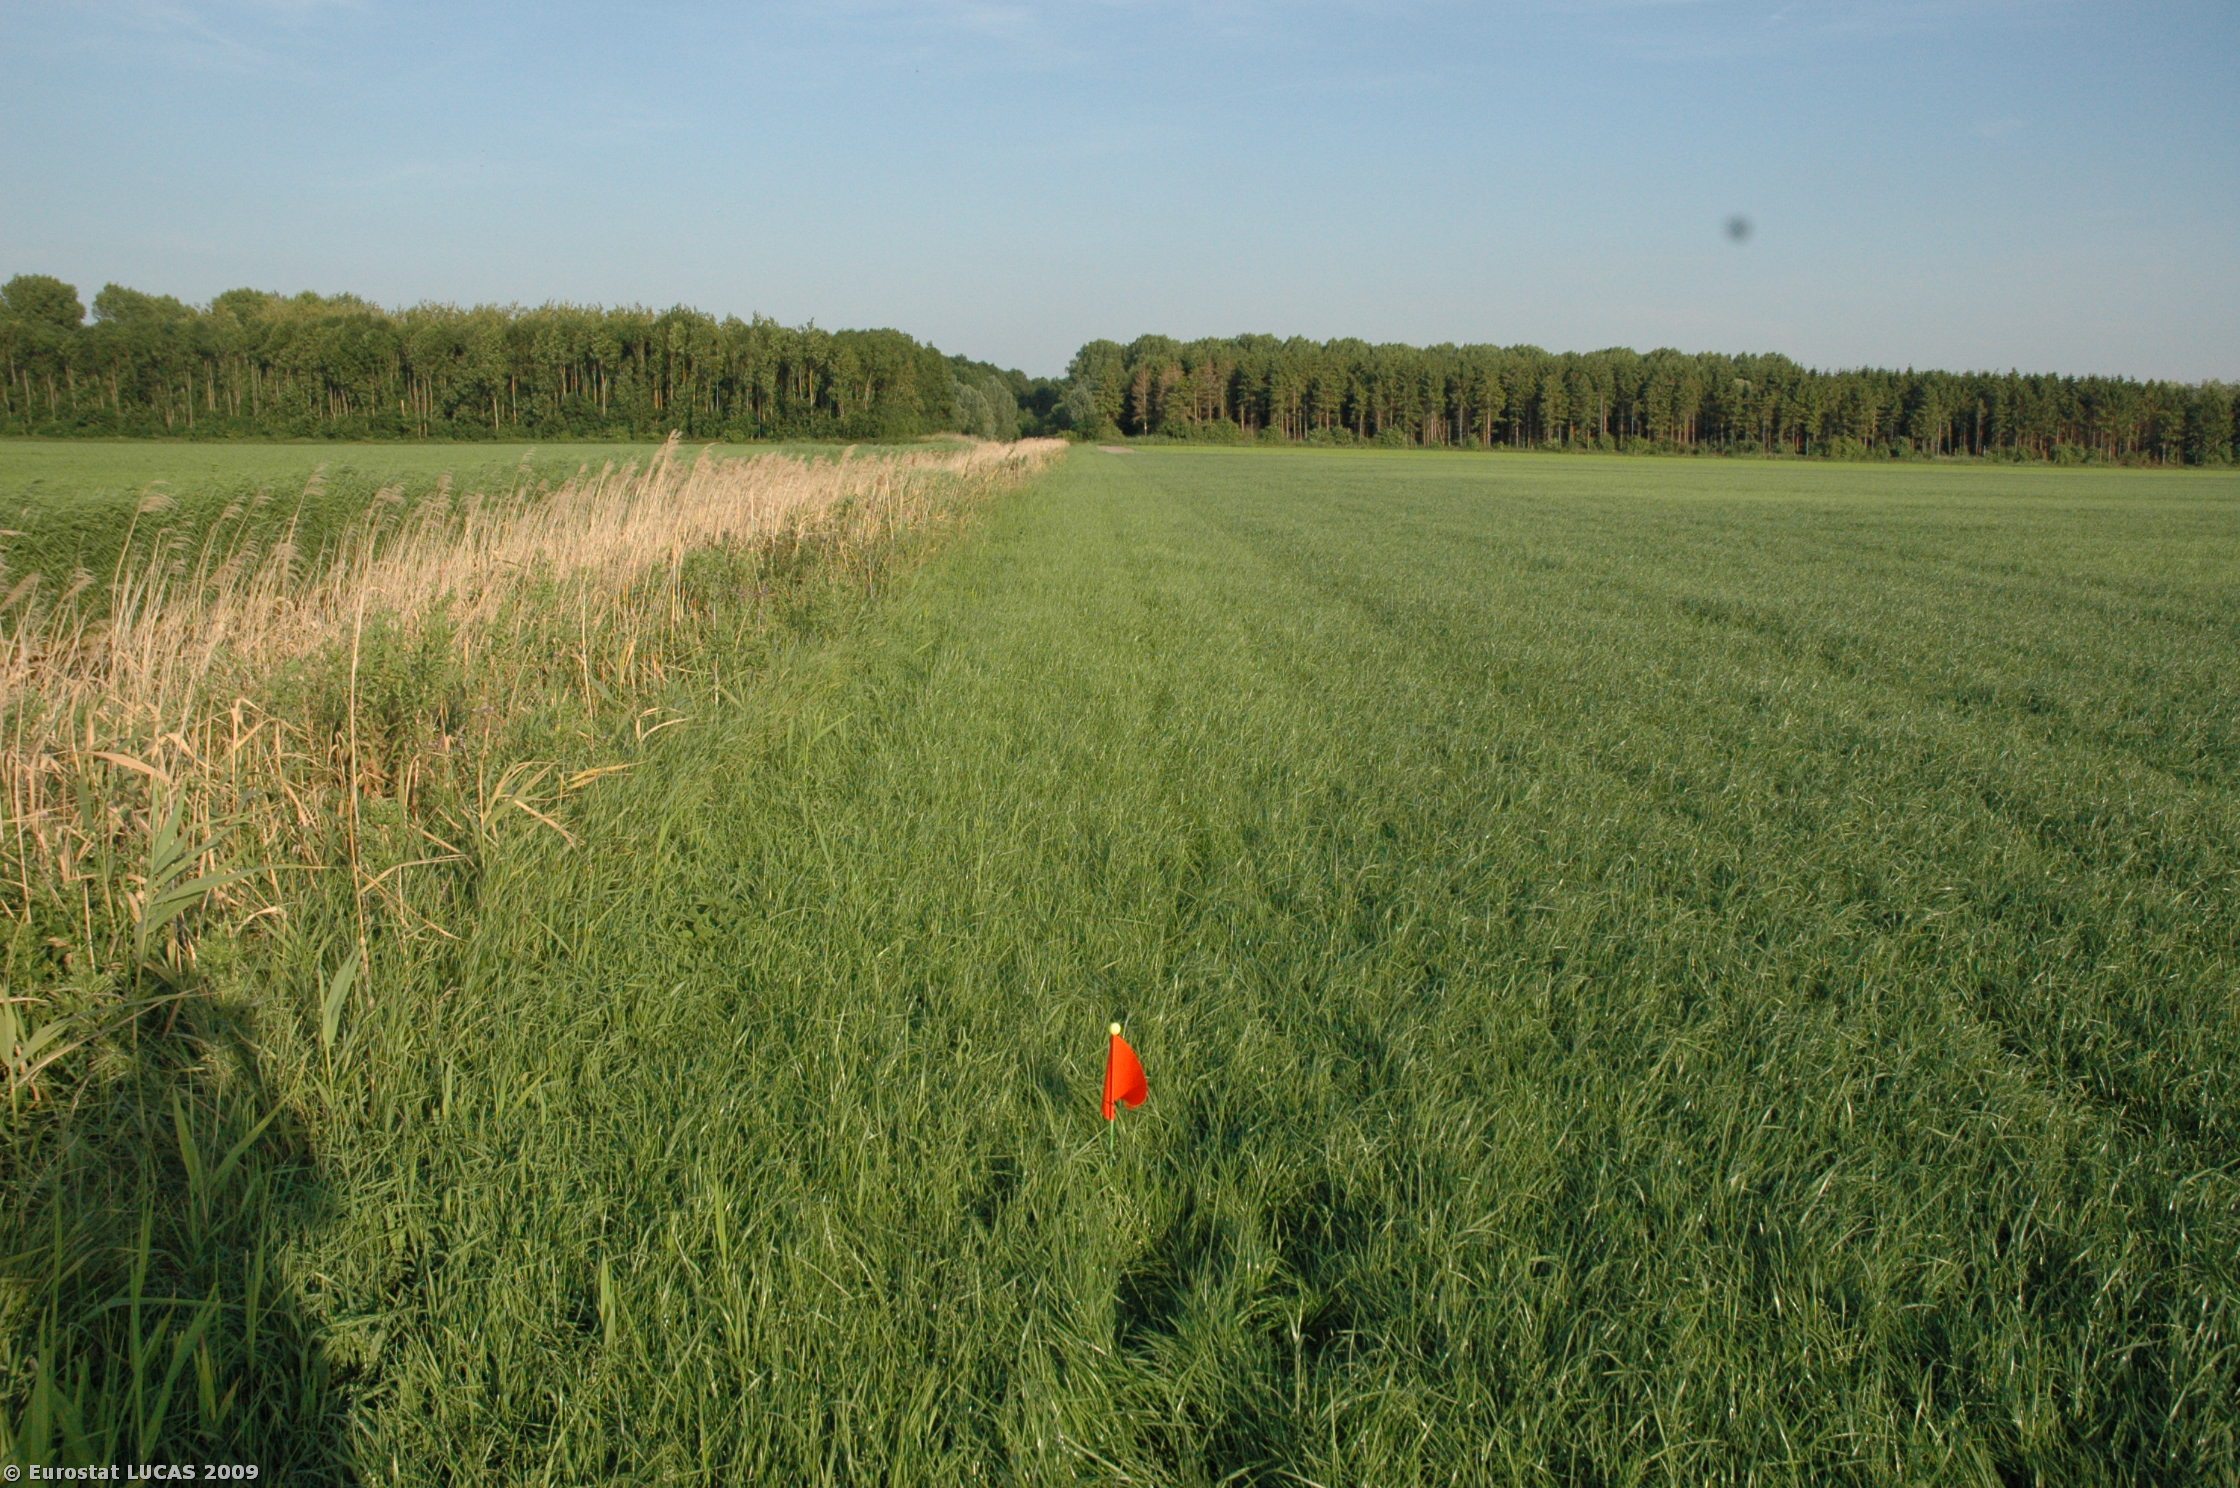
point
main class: Grassland
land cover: Grassland without tree/shrub cover
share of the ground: > 75 %
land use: Agriculture (excluding fallow land and kitchen gardens)
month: June
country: NL
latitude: 52.2708
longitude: 5.4113
